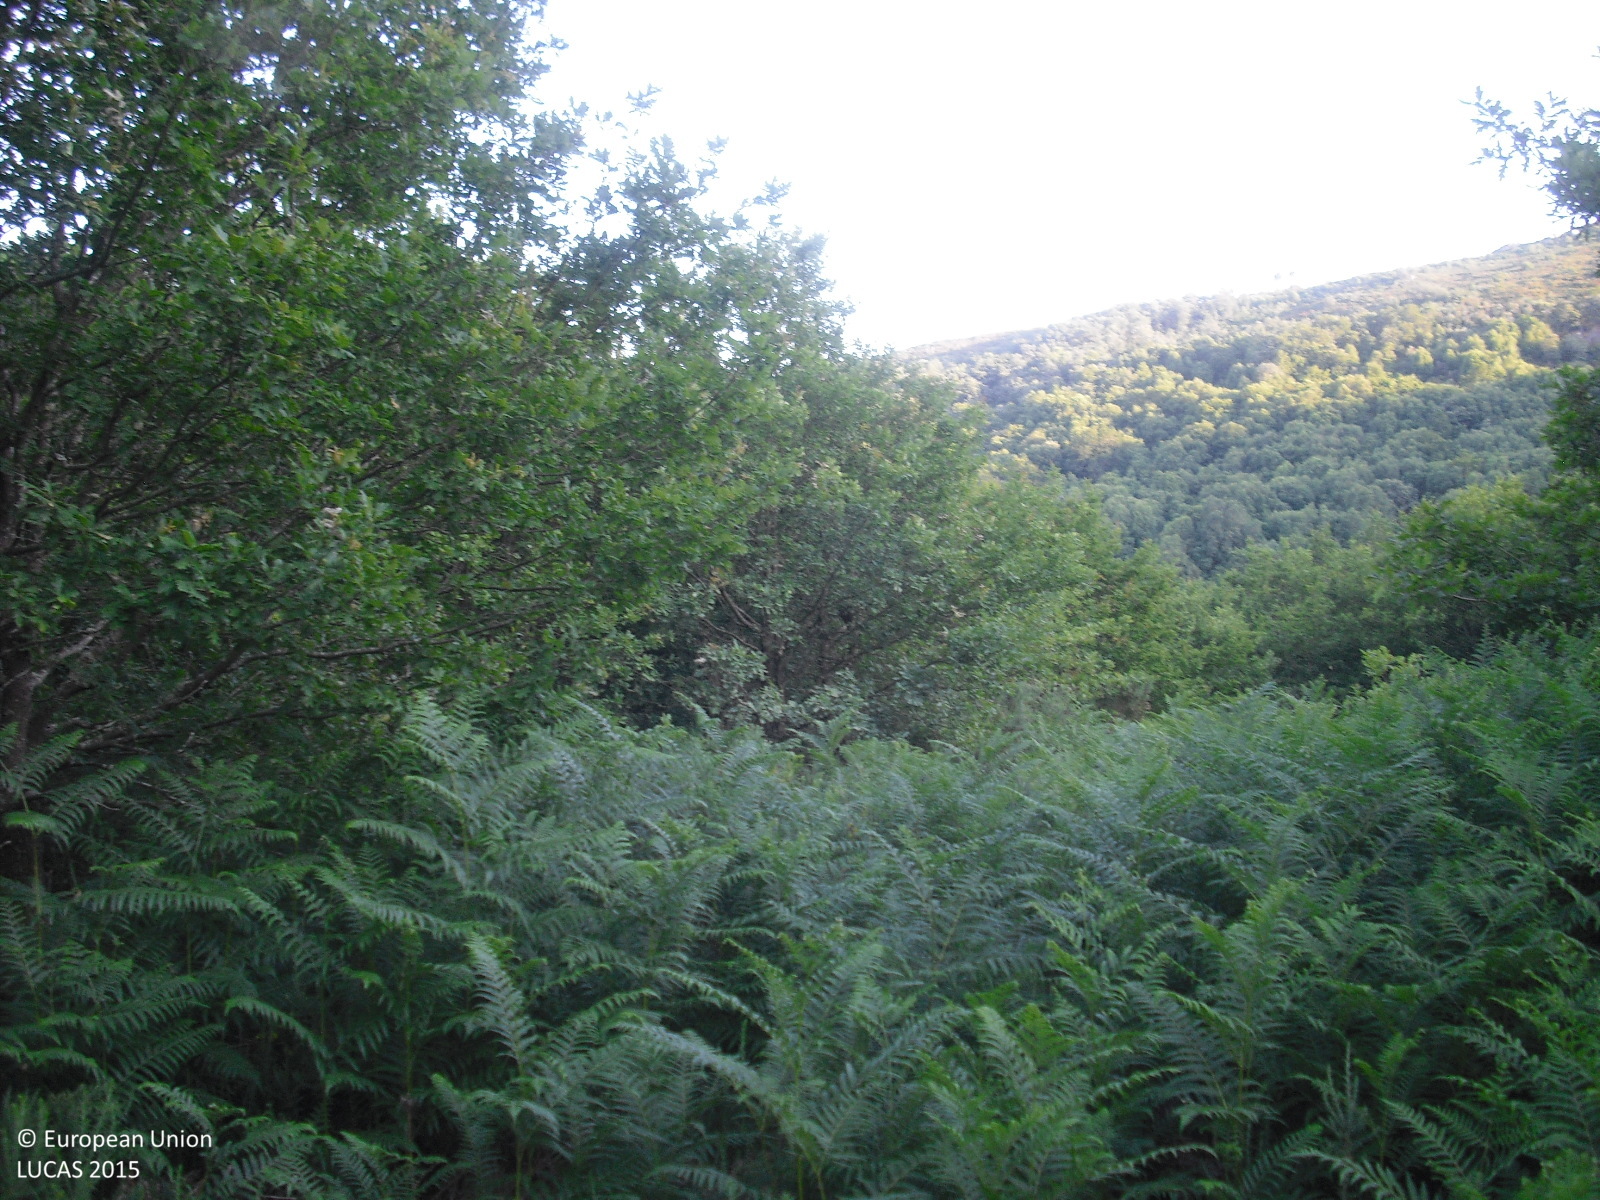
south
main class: Woodland
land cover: Broadleaved woodland
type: thermophilous deciduous forest
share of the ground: 50 - 75 %
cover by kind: broadleaved forest trees 60 %, shrubs 30 %, herbaceous plants 10 %
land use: Forestry
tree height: > 5 m
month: June
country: ES
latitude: 42.5571
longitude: -7.8999
